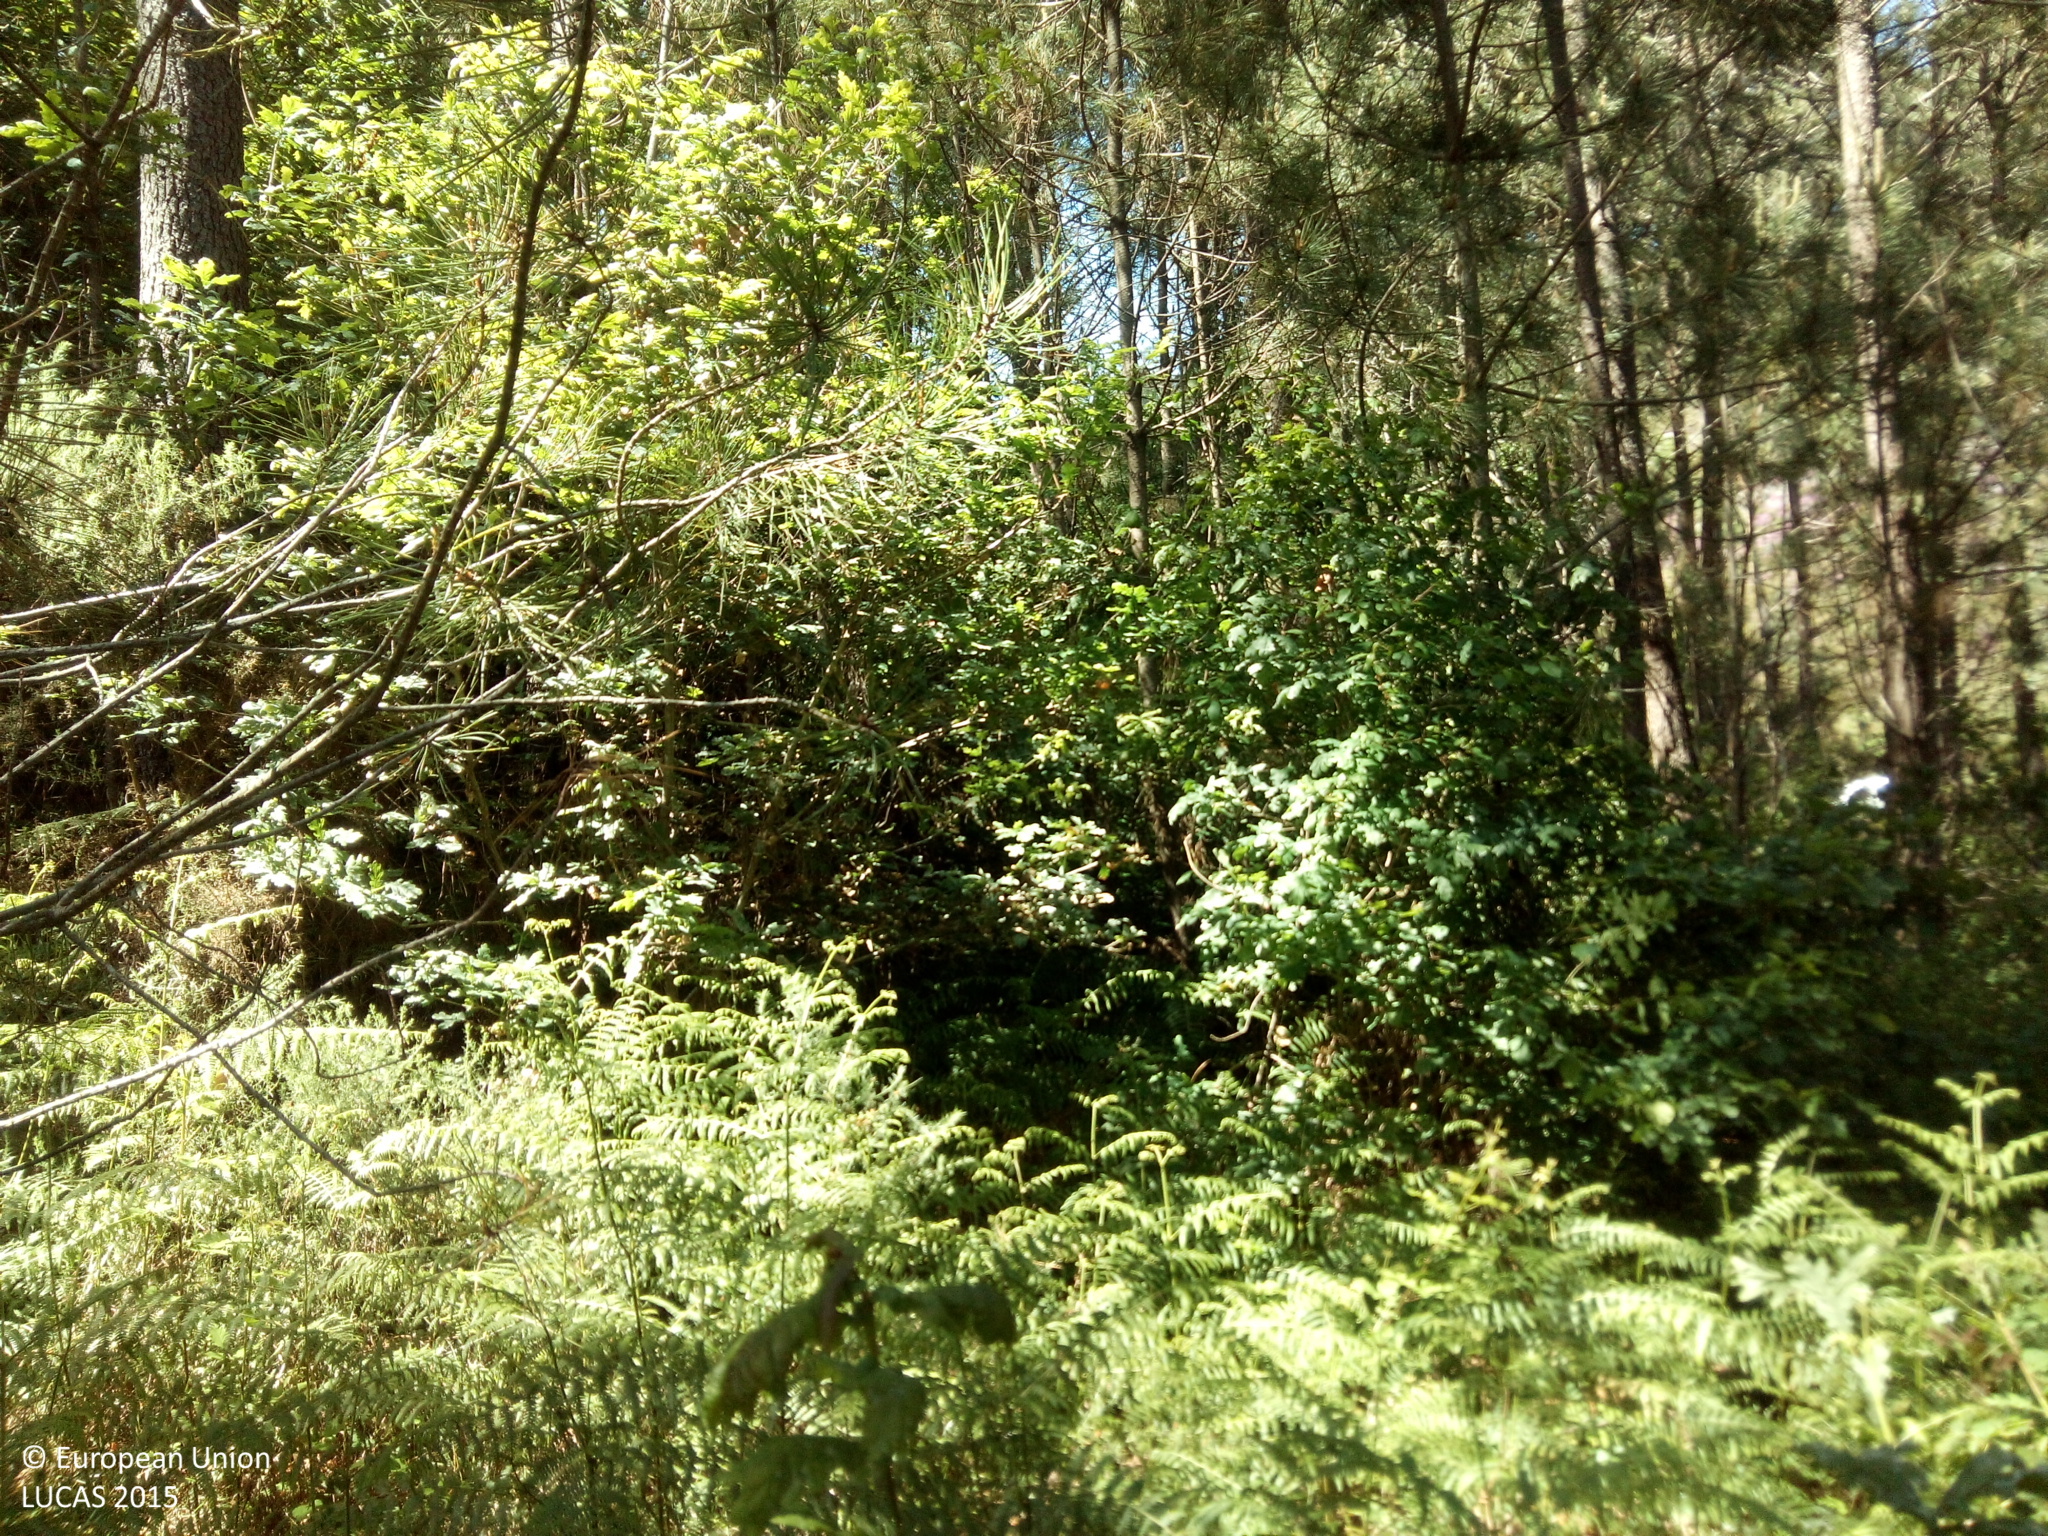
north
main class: Woodland
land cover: Pine dominated coniferous woodland
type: hemiboreal forest and nemoral coniferous forest and mixed broadleaved-coniferous forest
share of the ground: > 75 %
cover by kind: coniferous forest trees 75 %, shrubs 25 %
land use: Forestry
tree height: > 5 m
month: May
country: ES
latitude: 42.6690
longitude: -8.9918
